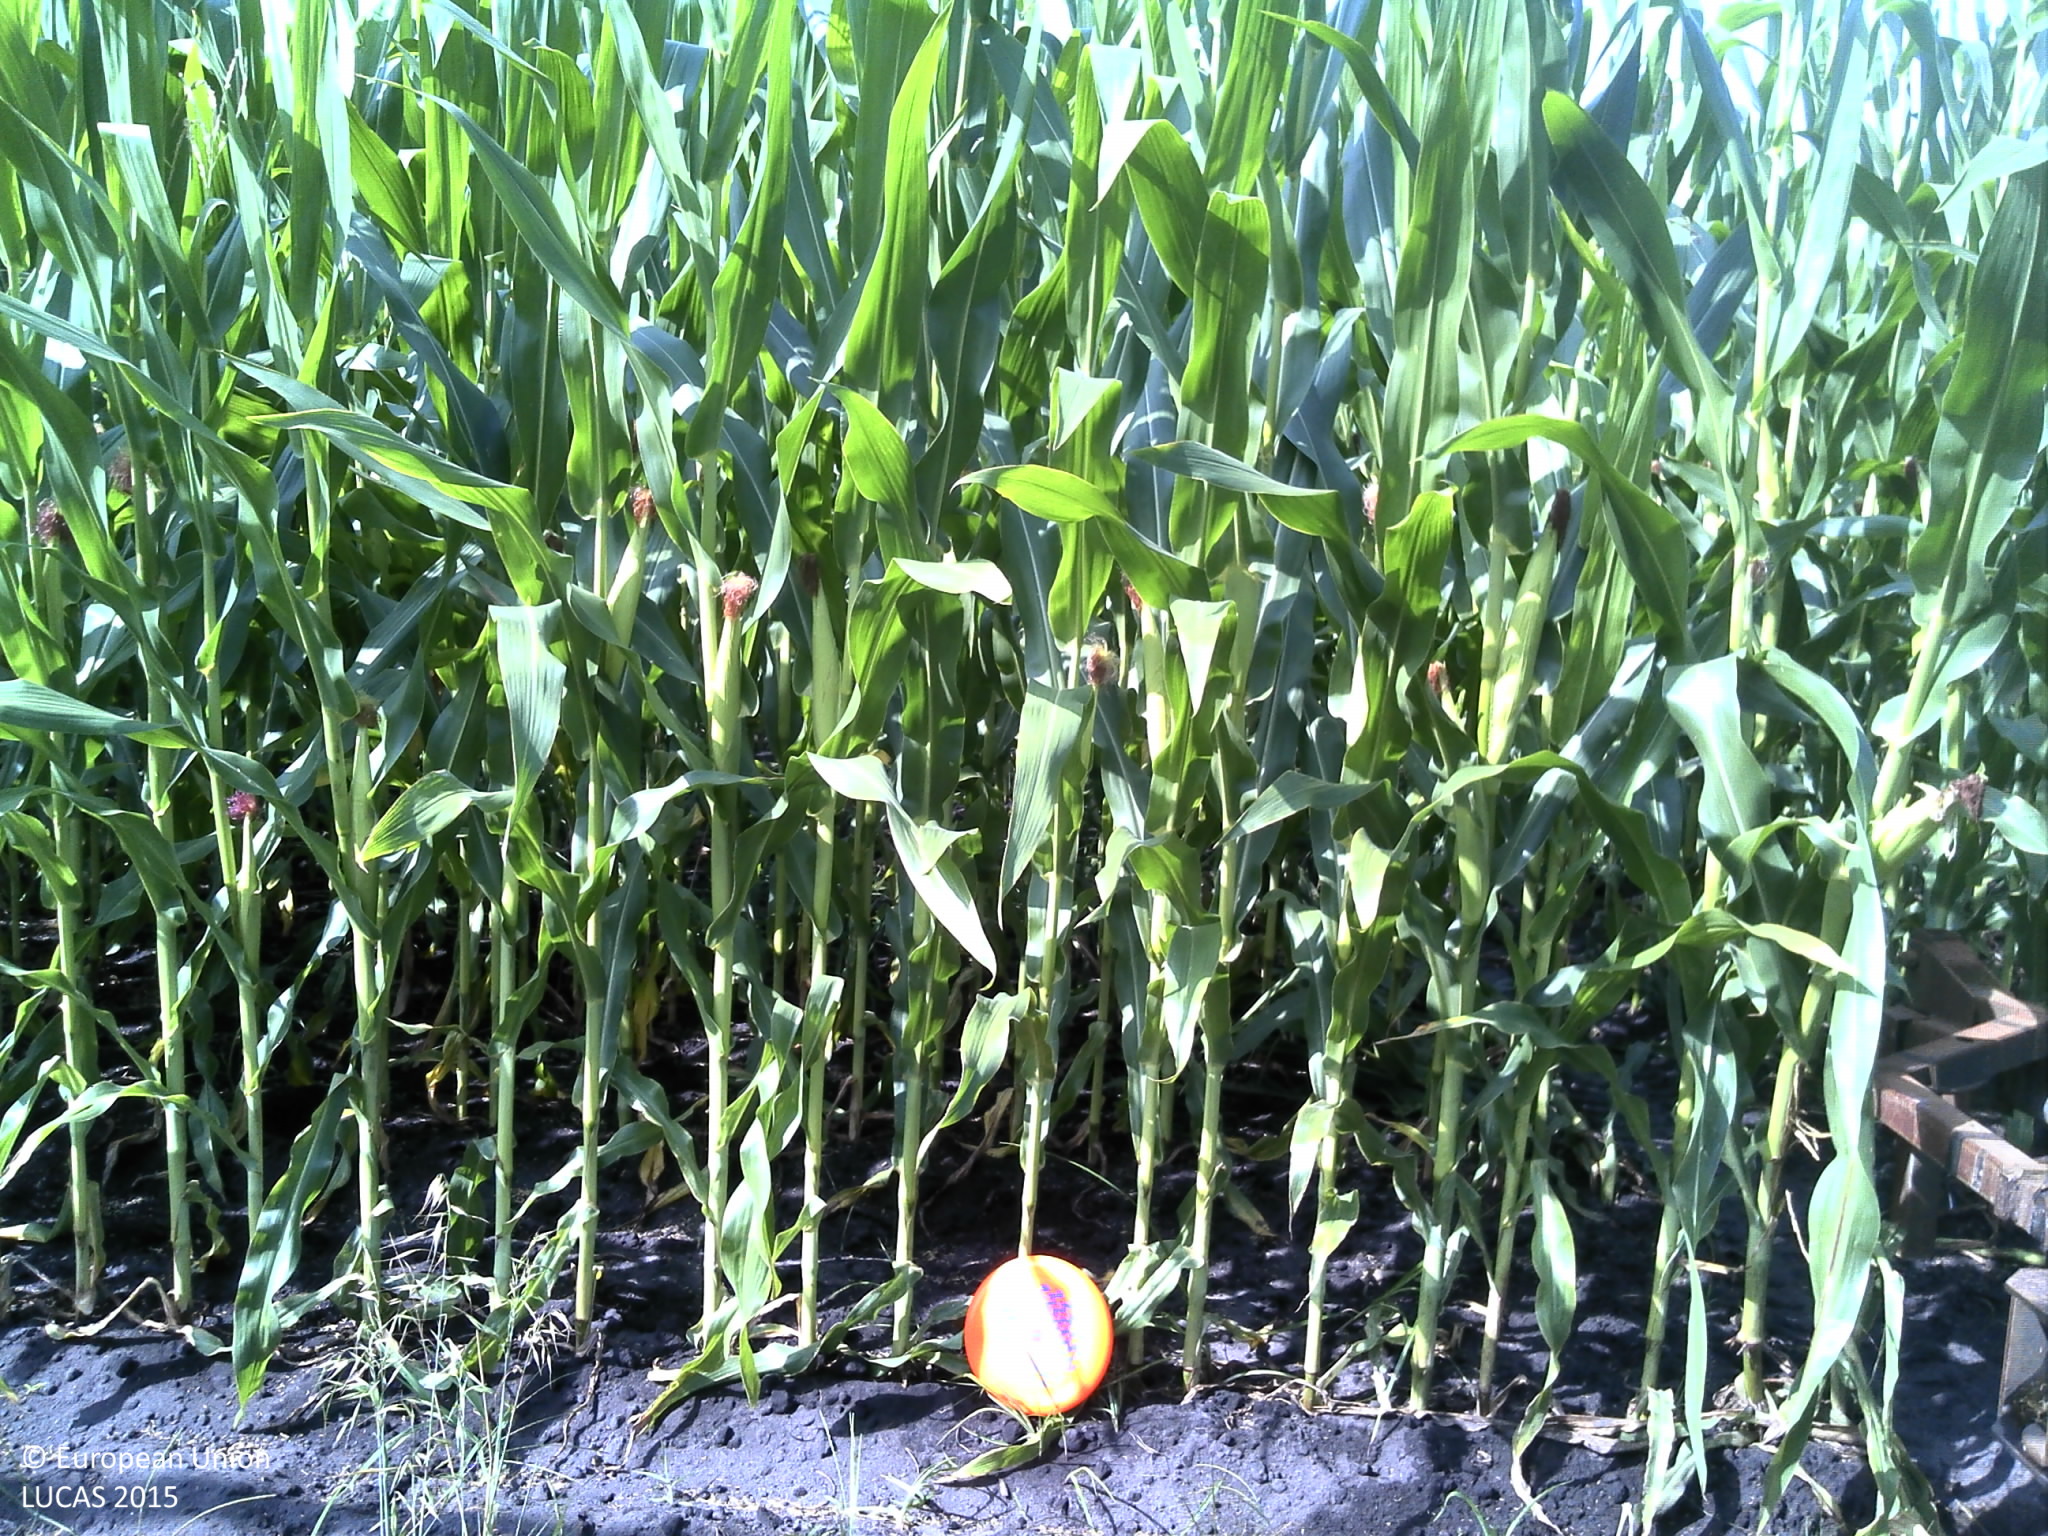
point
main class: Cropland
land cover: Maize
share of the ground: > 75 %
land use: Agriculture (excluding fallow land and kitchen gardens)
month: July
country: FR
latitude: 44.5993
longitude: -0.6635
